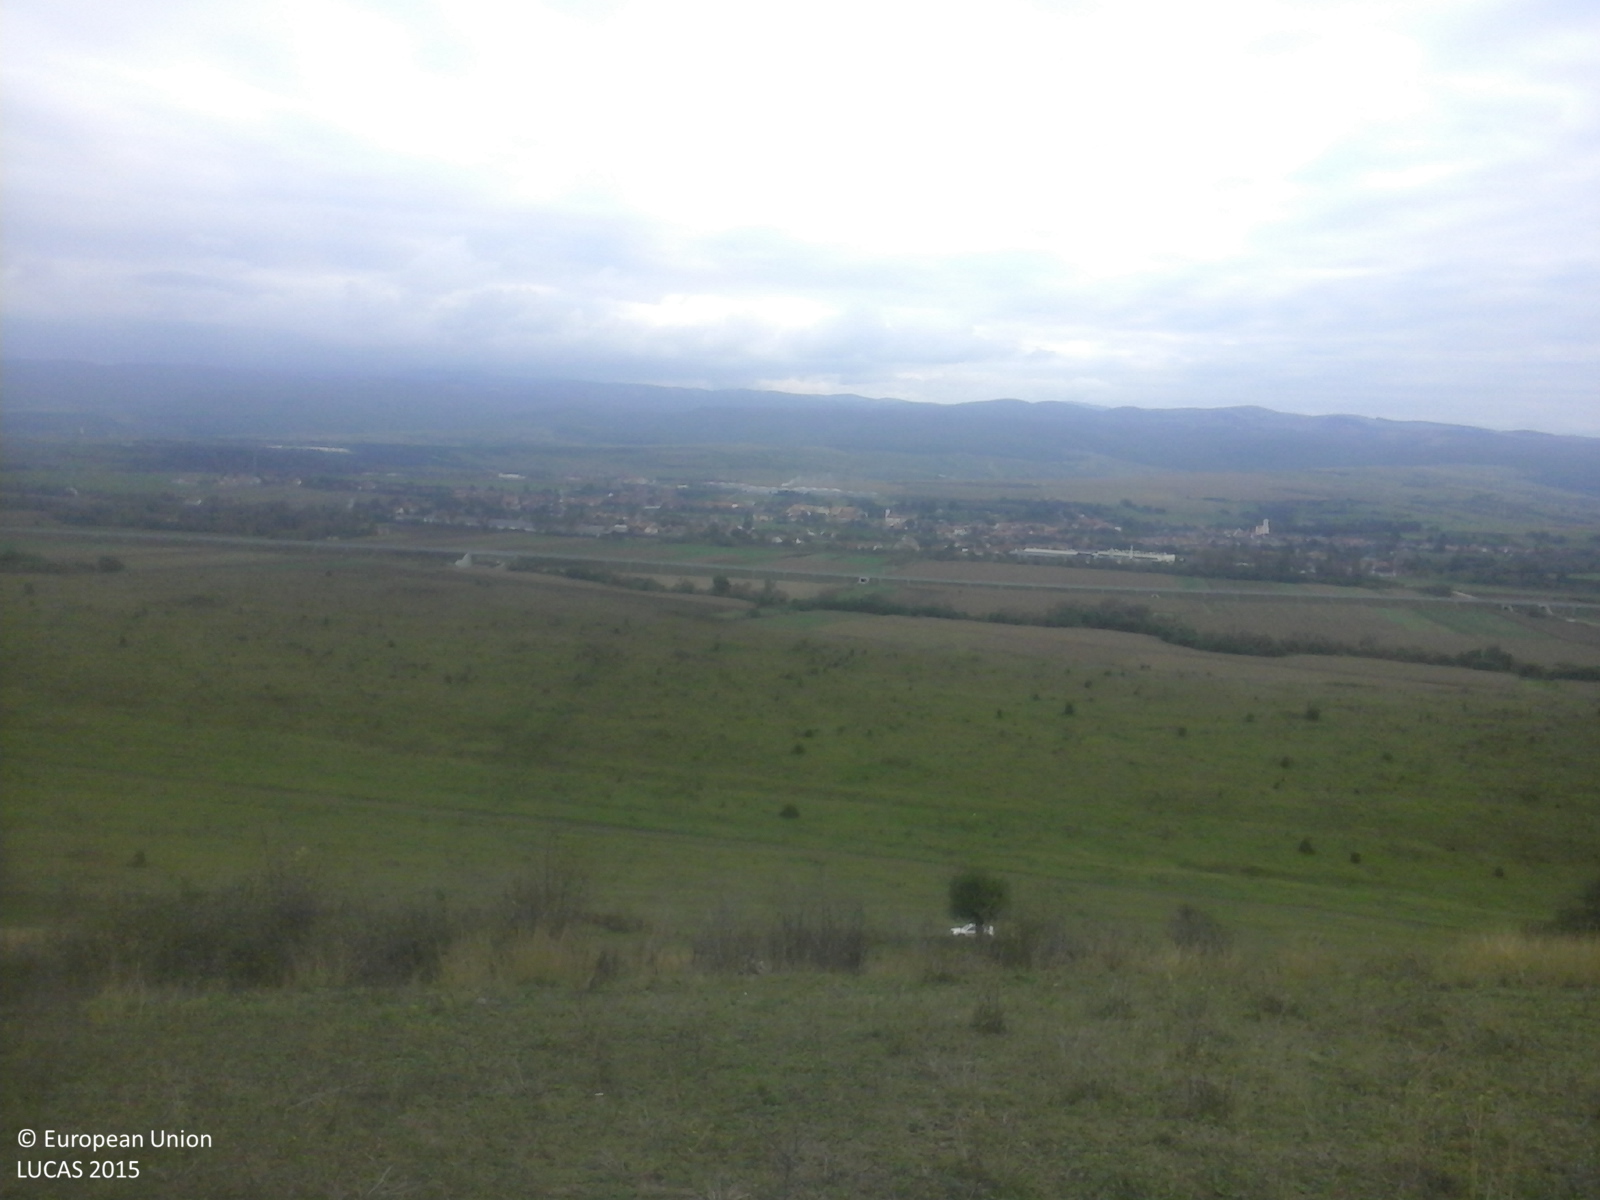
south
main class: Grassland
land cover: Grassland with sparse tree/shrub cover
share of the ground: > 75 %
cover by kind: herbaceous plants 85 %, shrubs 10 %, broadleaved forest trees 5 %
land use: Fallow land
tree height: < 5 m
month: September
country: RO
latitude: 45.9083
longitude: 23.7982
